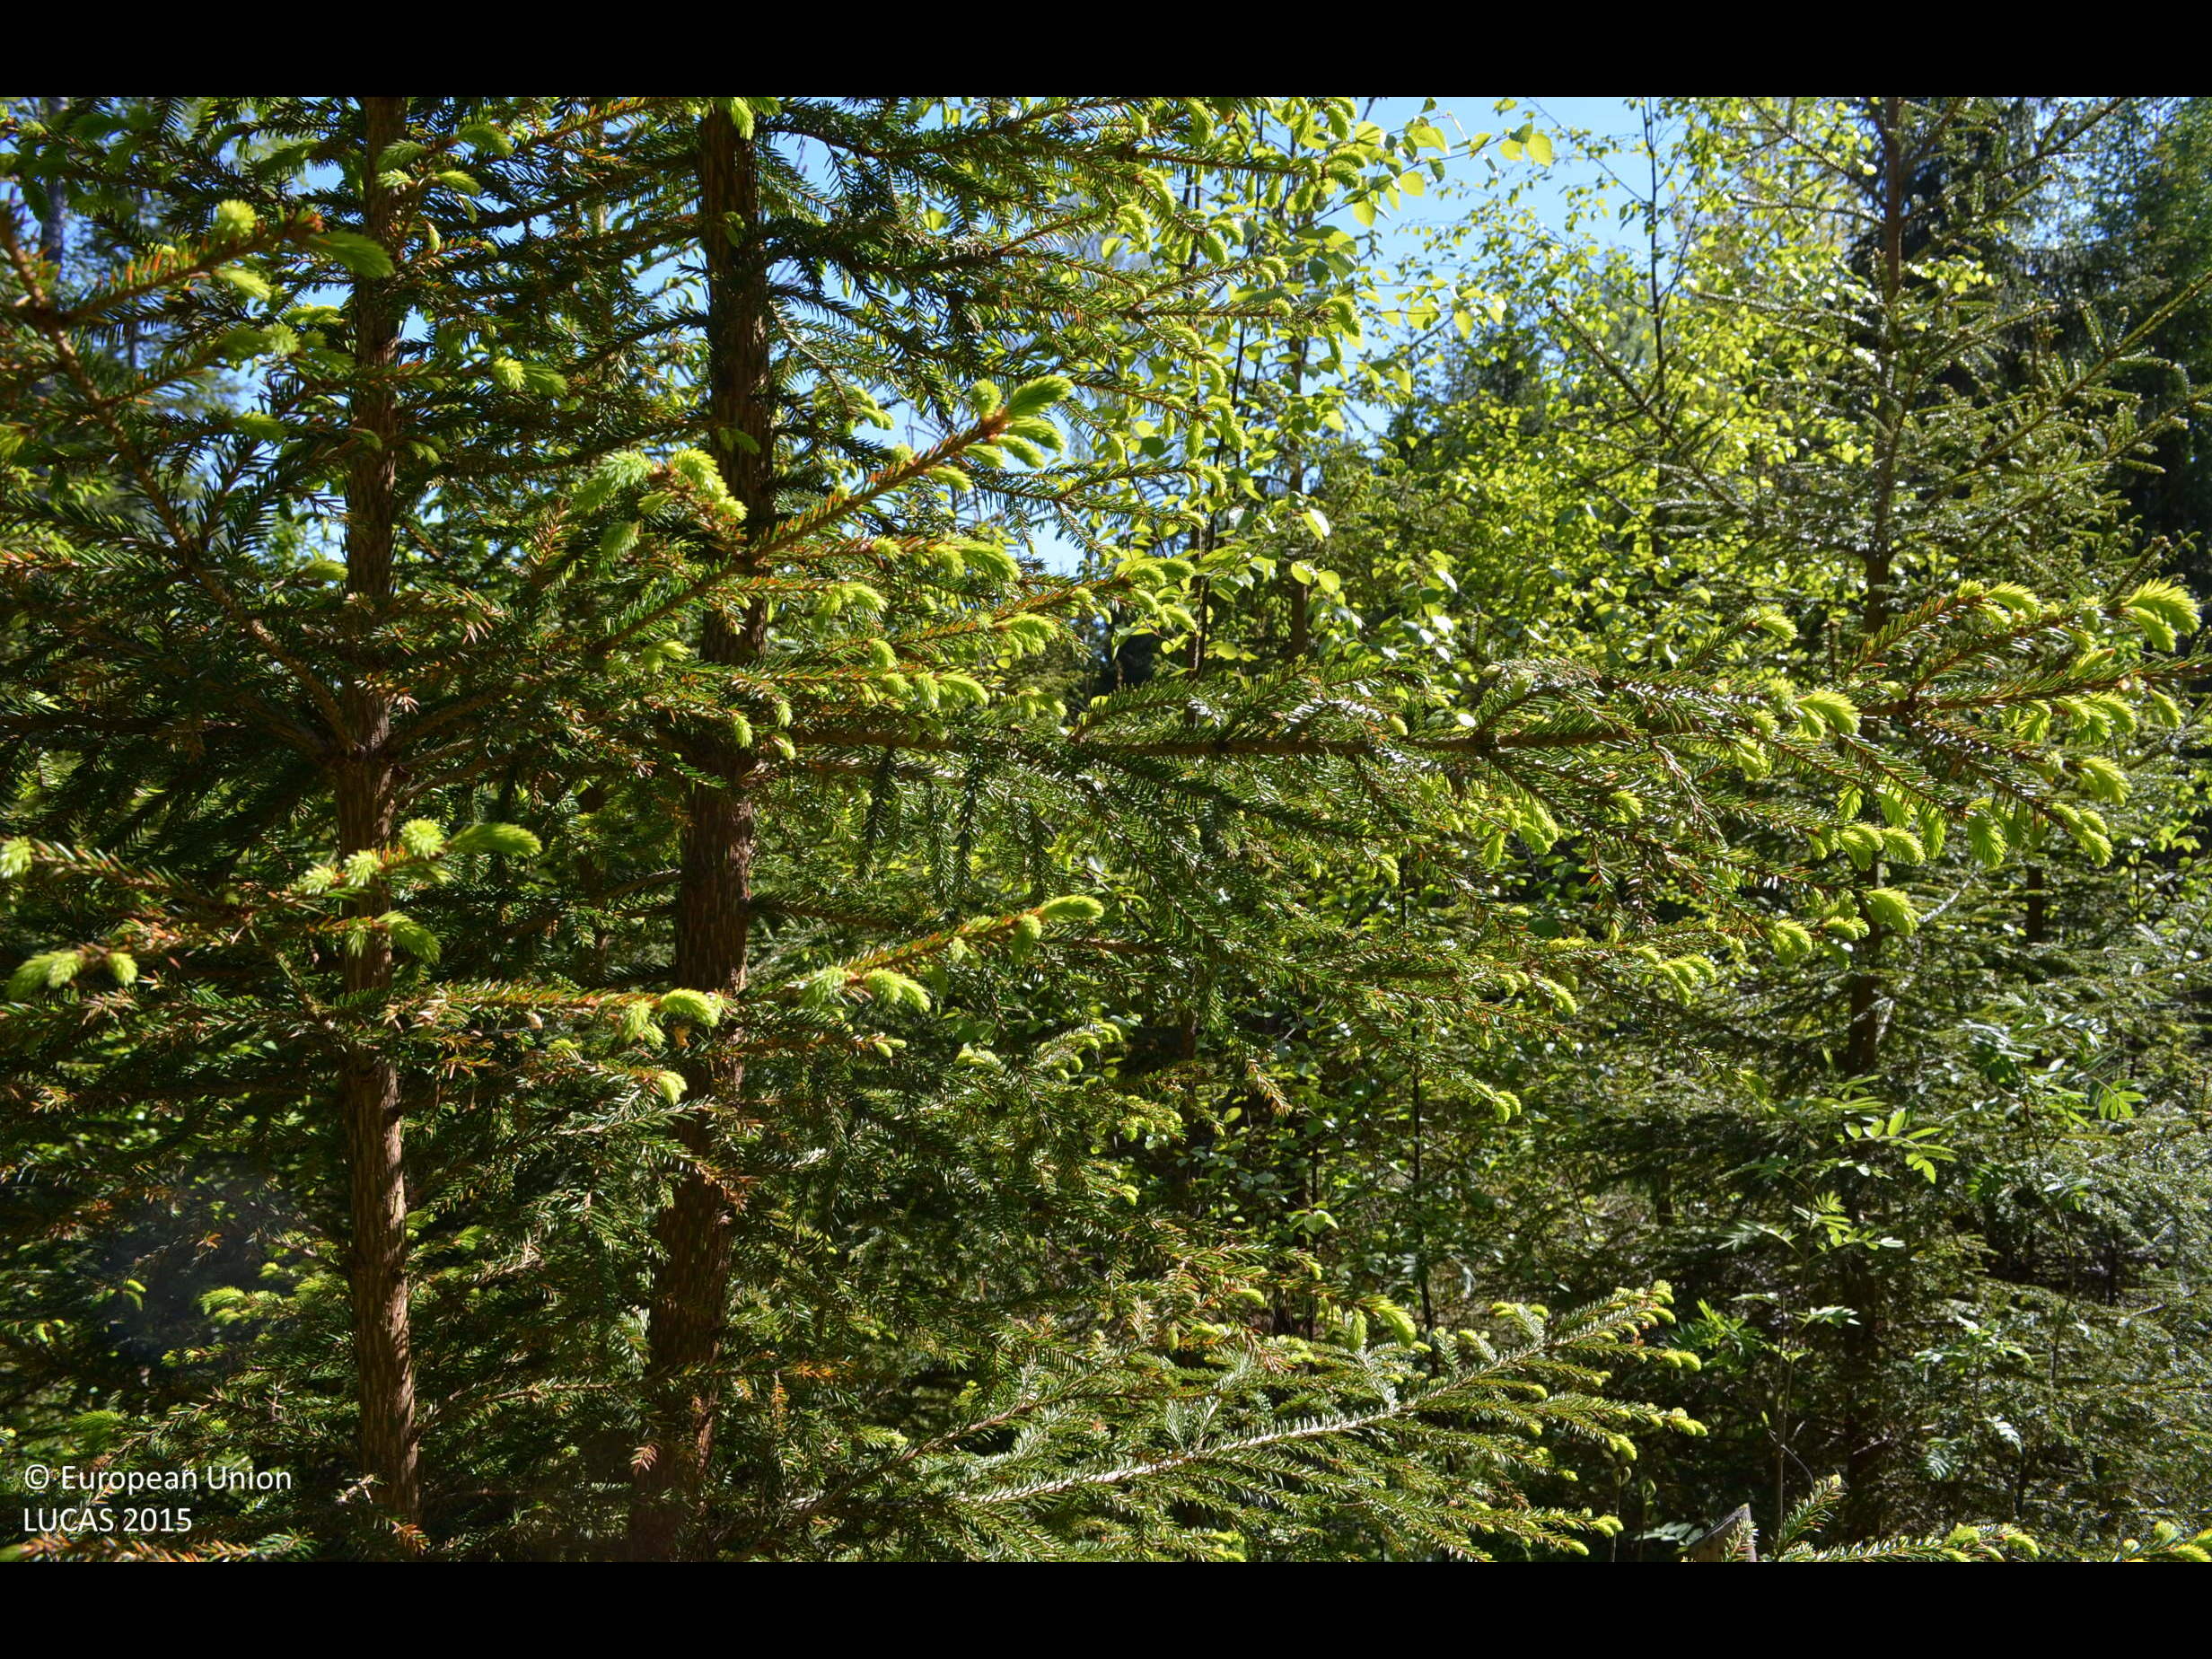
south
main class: Woodland
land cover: Spruce dominated coniferous woodland
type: boreal forest
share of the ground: > 75 %
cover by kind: coniferous forest trees 75 %, shrubs 10 %, herbaceous plants 10 %, broadleaved forest trees 5 %
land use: Forestry
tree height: < 5 m
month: June
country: FI
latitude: 61.8449
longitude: 23.1987
